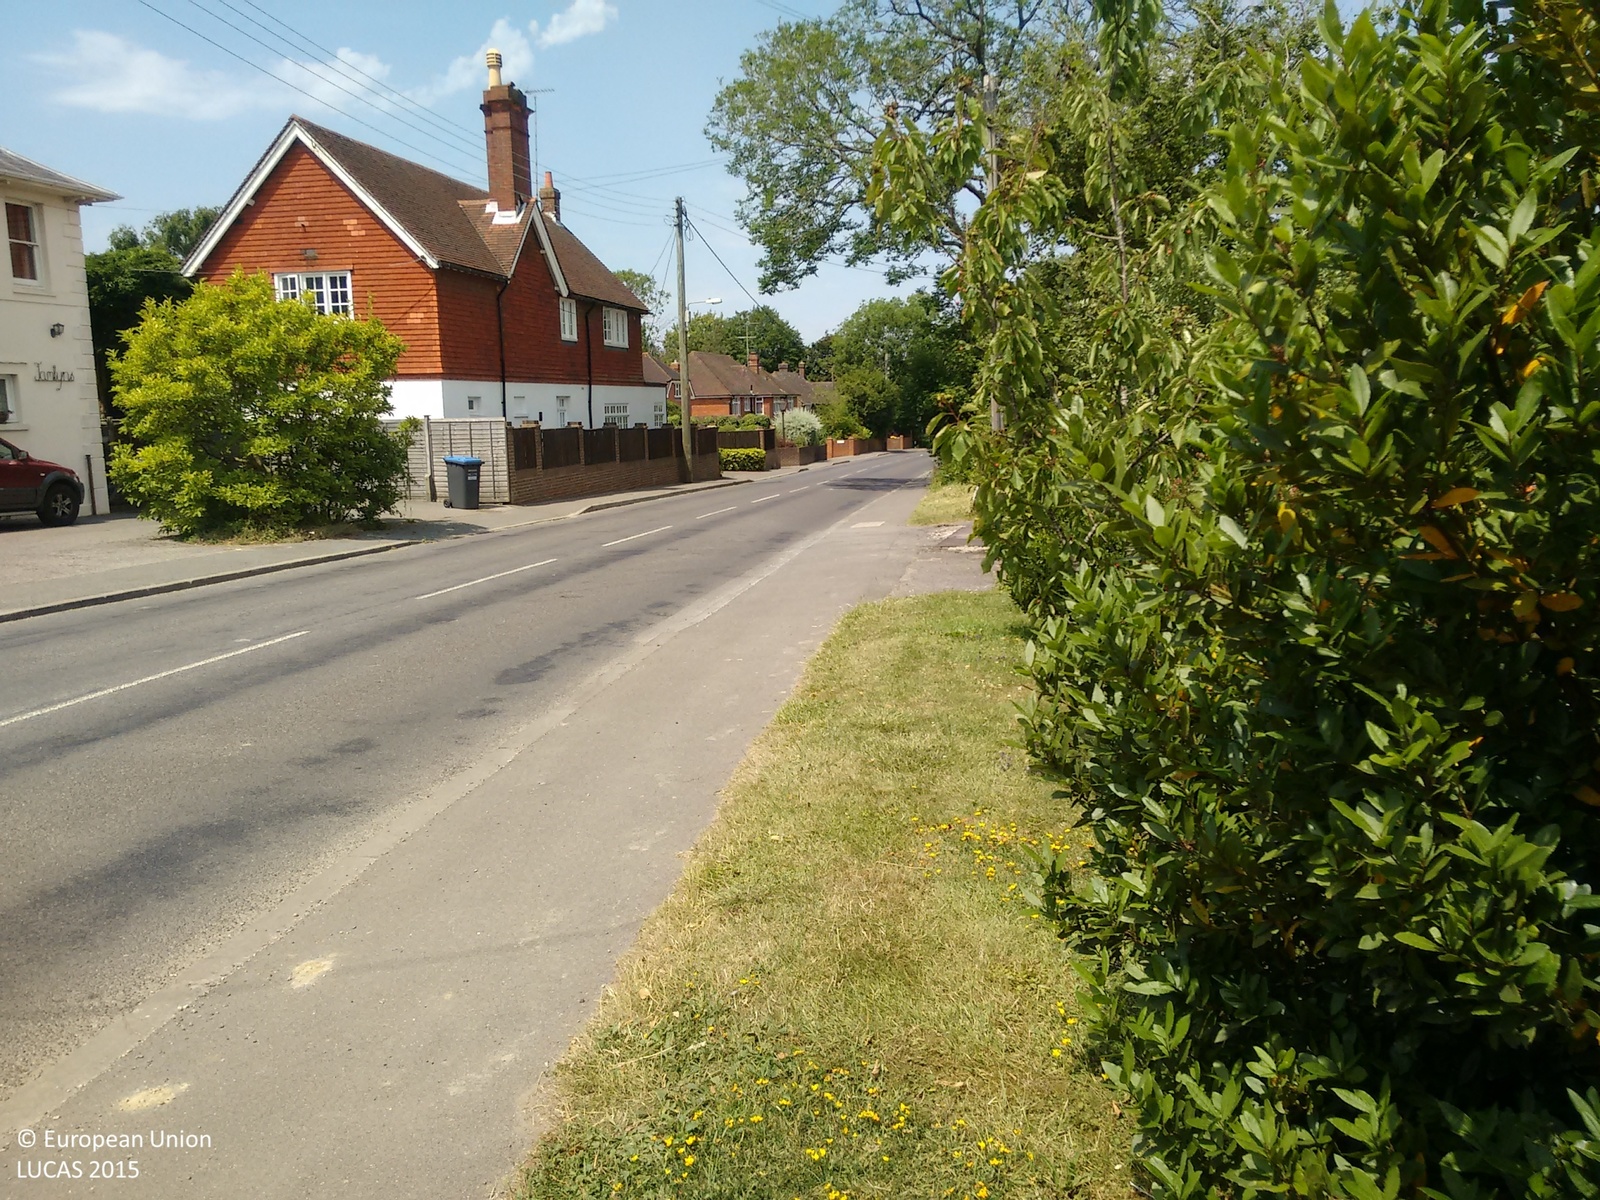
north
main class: Grassland
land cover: Grassland with sparse tree/shrub cover
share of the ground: > 75 %
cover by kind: herbaceous plants 85 %, shrubs 10 %, broadleaved forest trees 5 %
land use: Residential
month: July
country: GB
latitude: 50.9466
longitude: -0.1256
